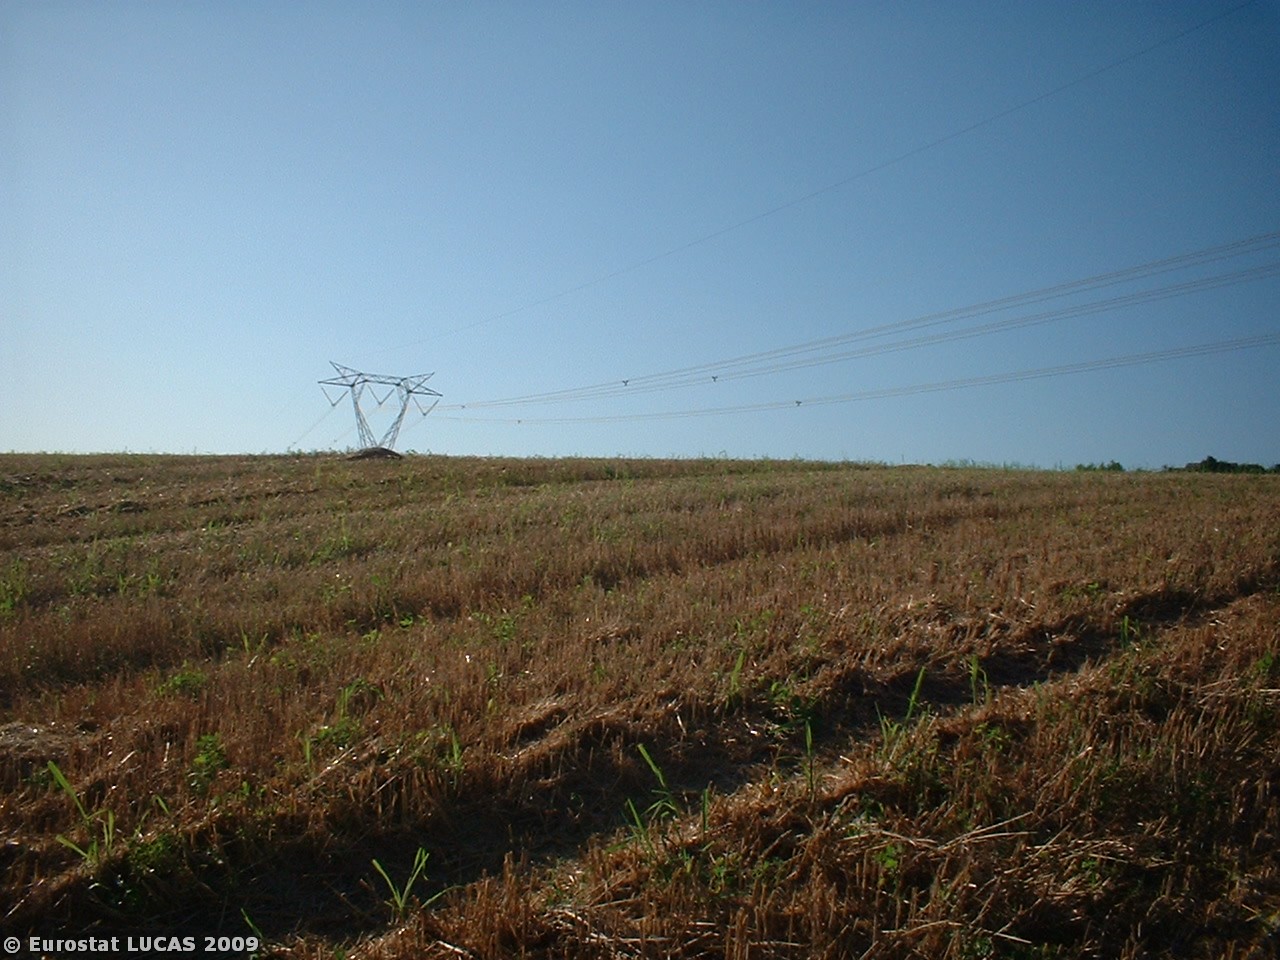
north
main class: Cropland
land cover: Durum wheat
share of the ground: < 10 %
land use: Agriculture (excluding fallow land and kitchen gardens)
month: July
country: IT
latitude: 43.6316
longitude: 13.2519
